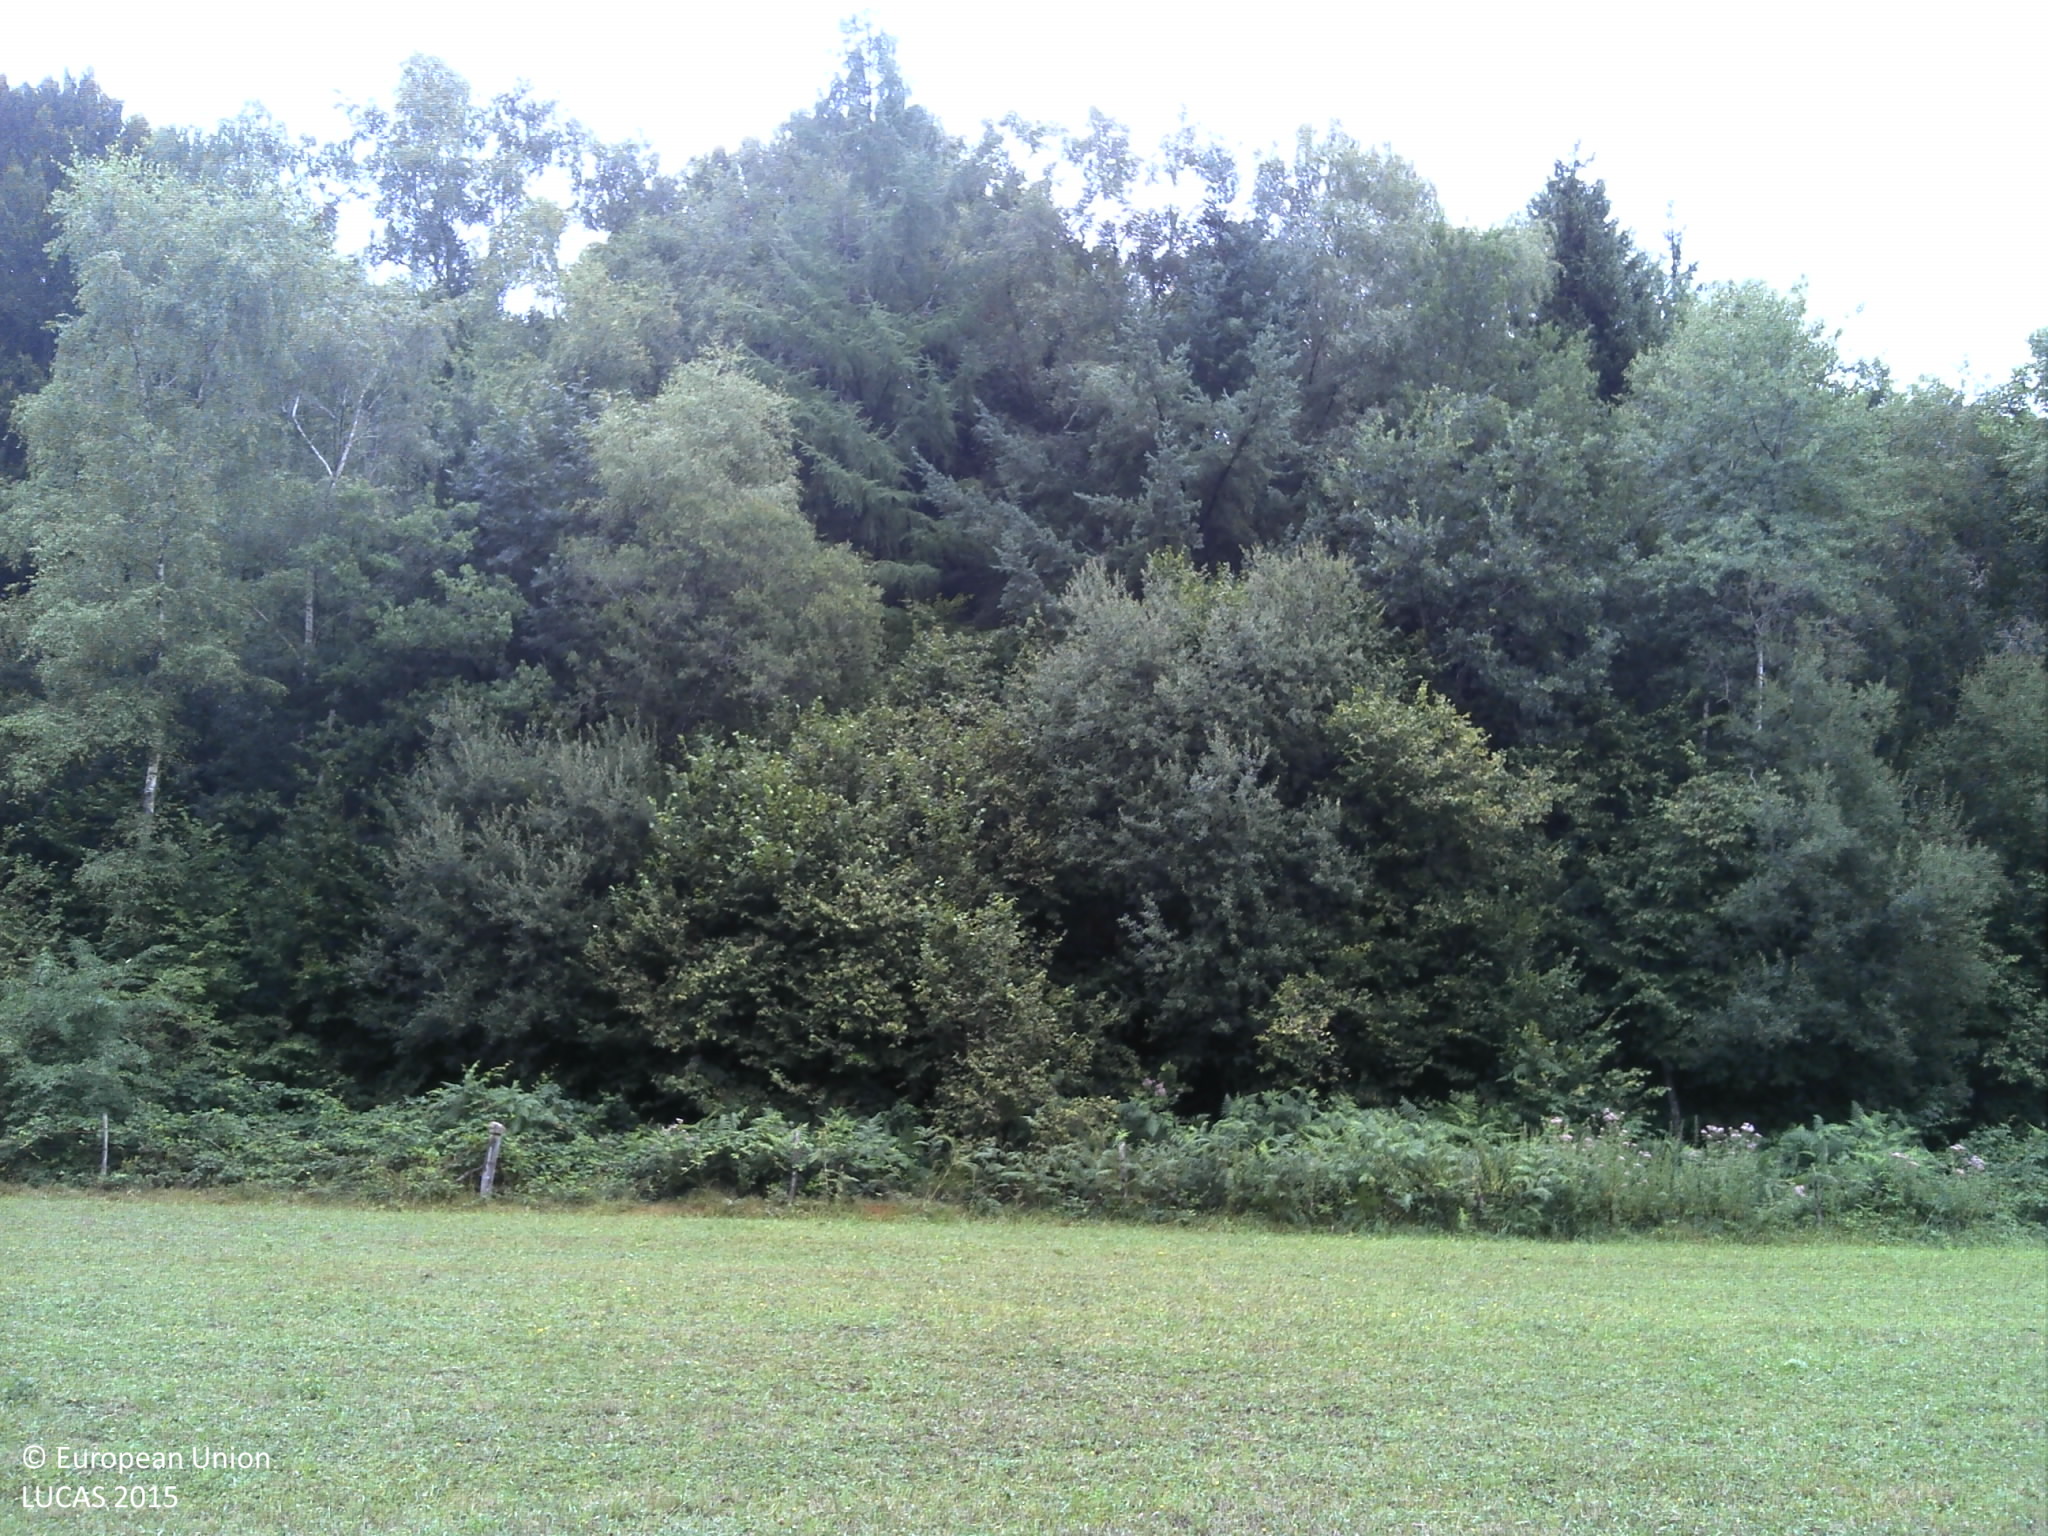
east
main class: Grassland
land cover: Grassland without tree/shrub cover
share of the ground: > 75 %
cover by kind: herbaceous plants 90 %, unconsolidated bare surface 10 %
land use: Agriculture (excluding fallow land and kitchen gardens)
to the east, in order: Grassland without tree/shrub cover; Electric lines; Grassland without tree/shrub cover; Fences; Spruce dominated mixed woodland; Ditches and canals; Spruce dominated mixed woodland; Broadleaved woodland; Fences; Grassland without tree/shrub cover; Fences; Grassland without tree/shrub cover
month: August
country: FR
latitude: 45.3516
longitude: 2.3271
